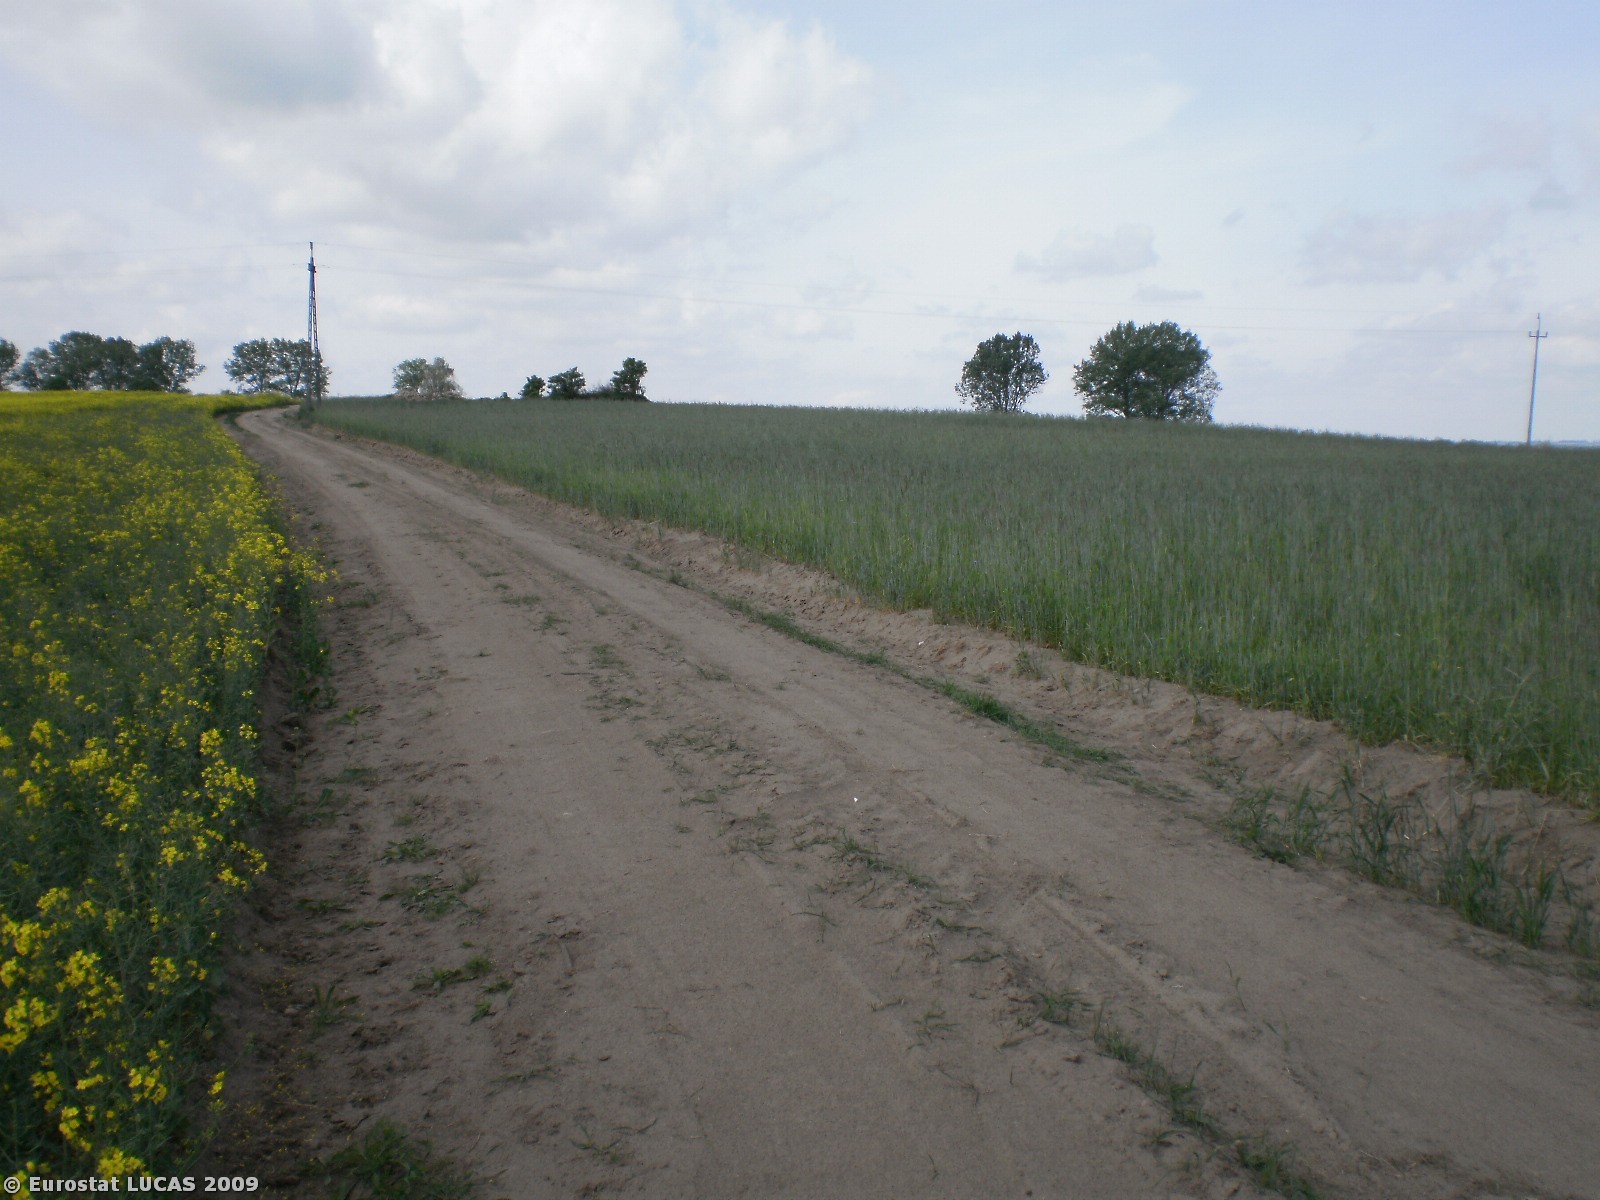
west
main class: Cropland
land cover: Rape and turnip rape
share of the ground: > 75 %
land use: Agriculture (excluding fallow land and kitchen gardens)
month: May
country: PL
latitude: 53.5663
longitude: 17.7894
